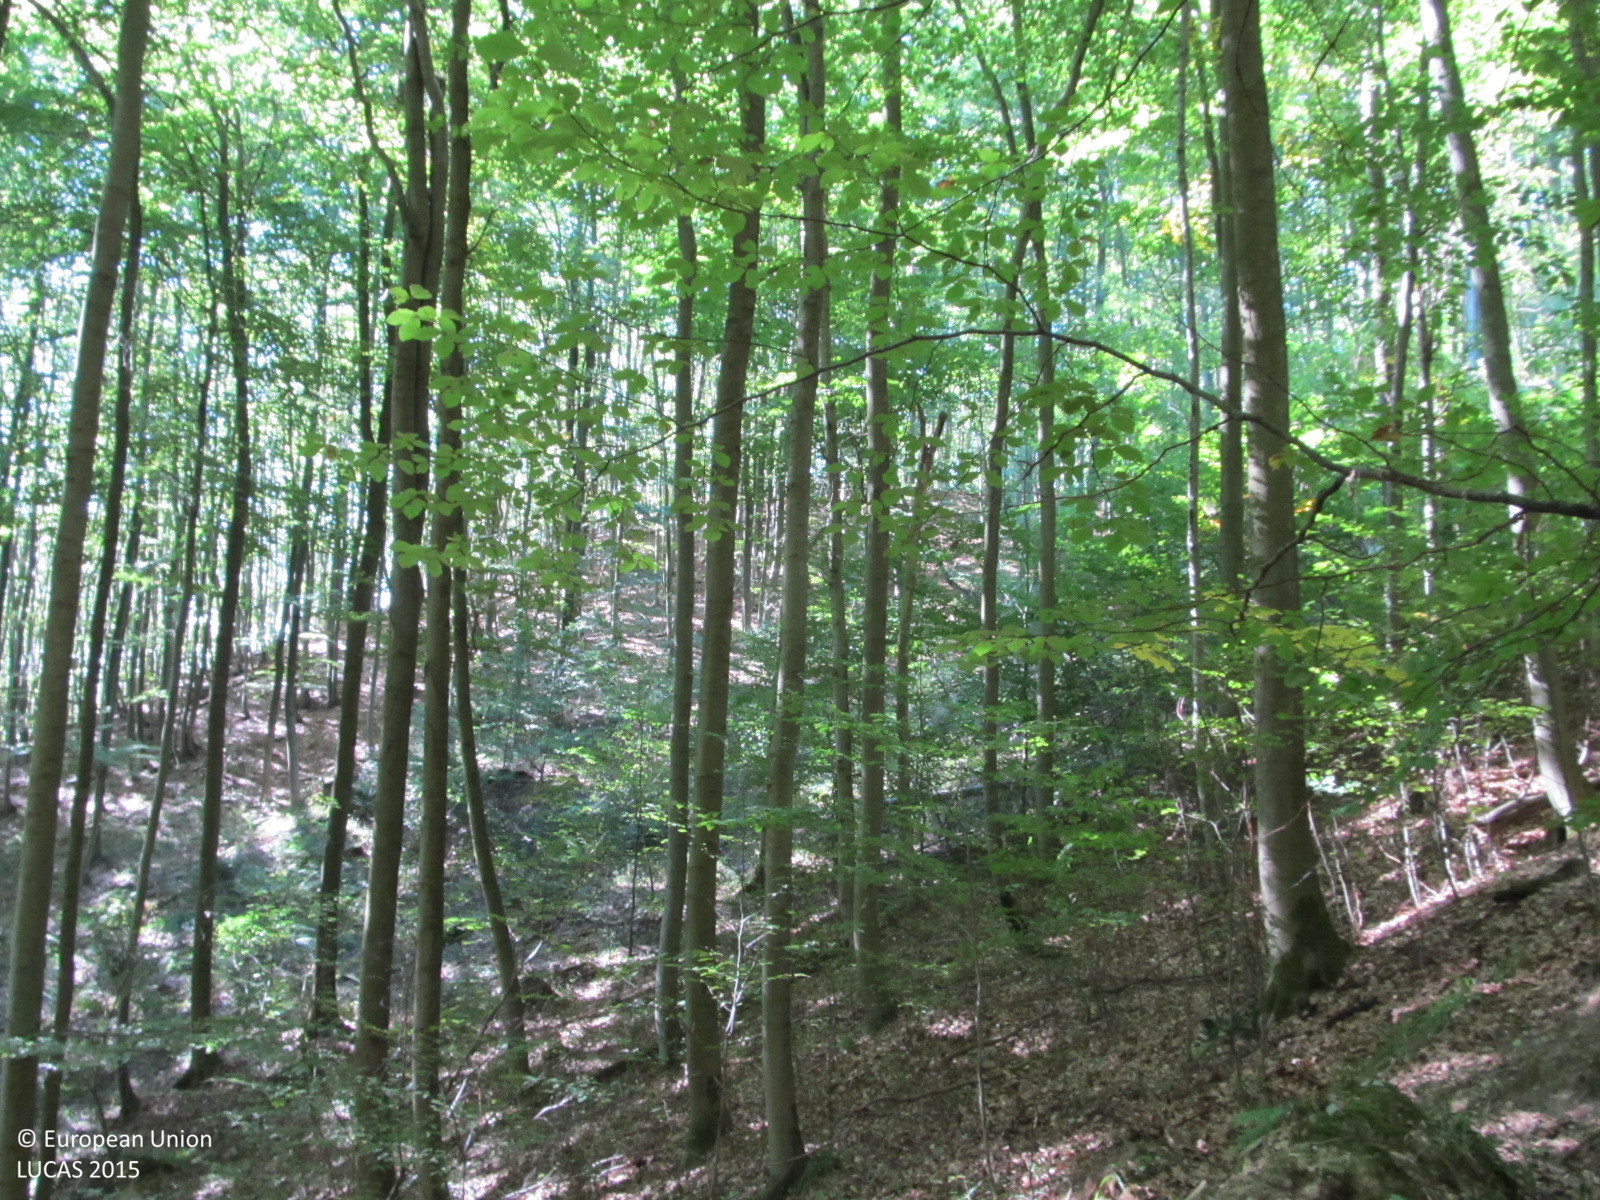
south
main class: Woodland
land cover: Broadleaved woodland
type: beech forest
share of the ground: > 75 %
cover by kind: broadleaved forest trees 85 %, unconsolidated bare surface 15 %
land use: Forestry
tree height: > 5 m
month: September
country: AT
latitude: 48.5005
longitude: 15.5111
